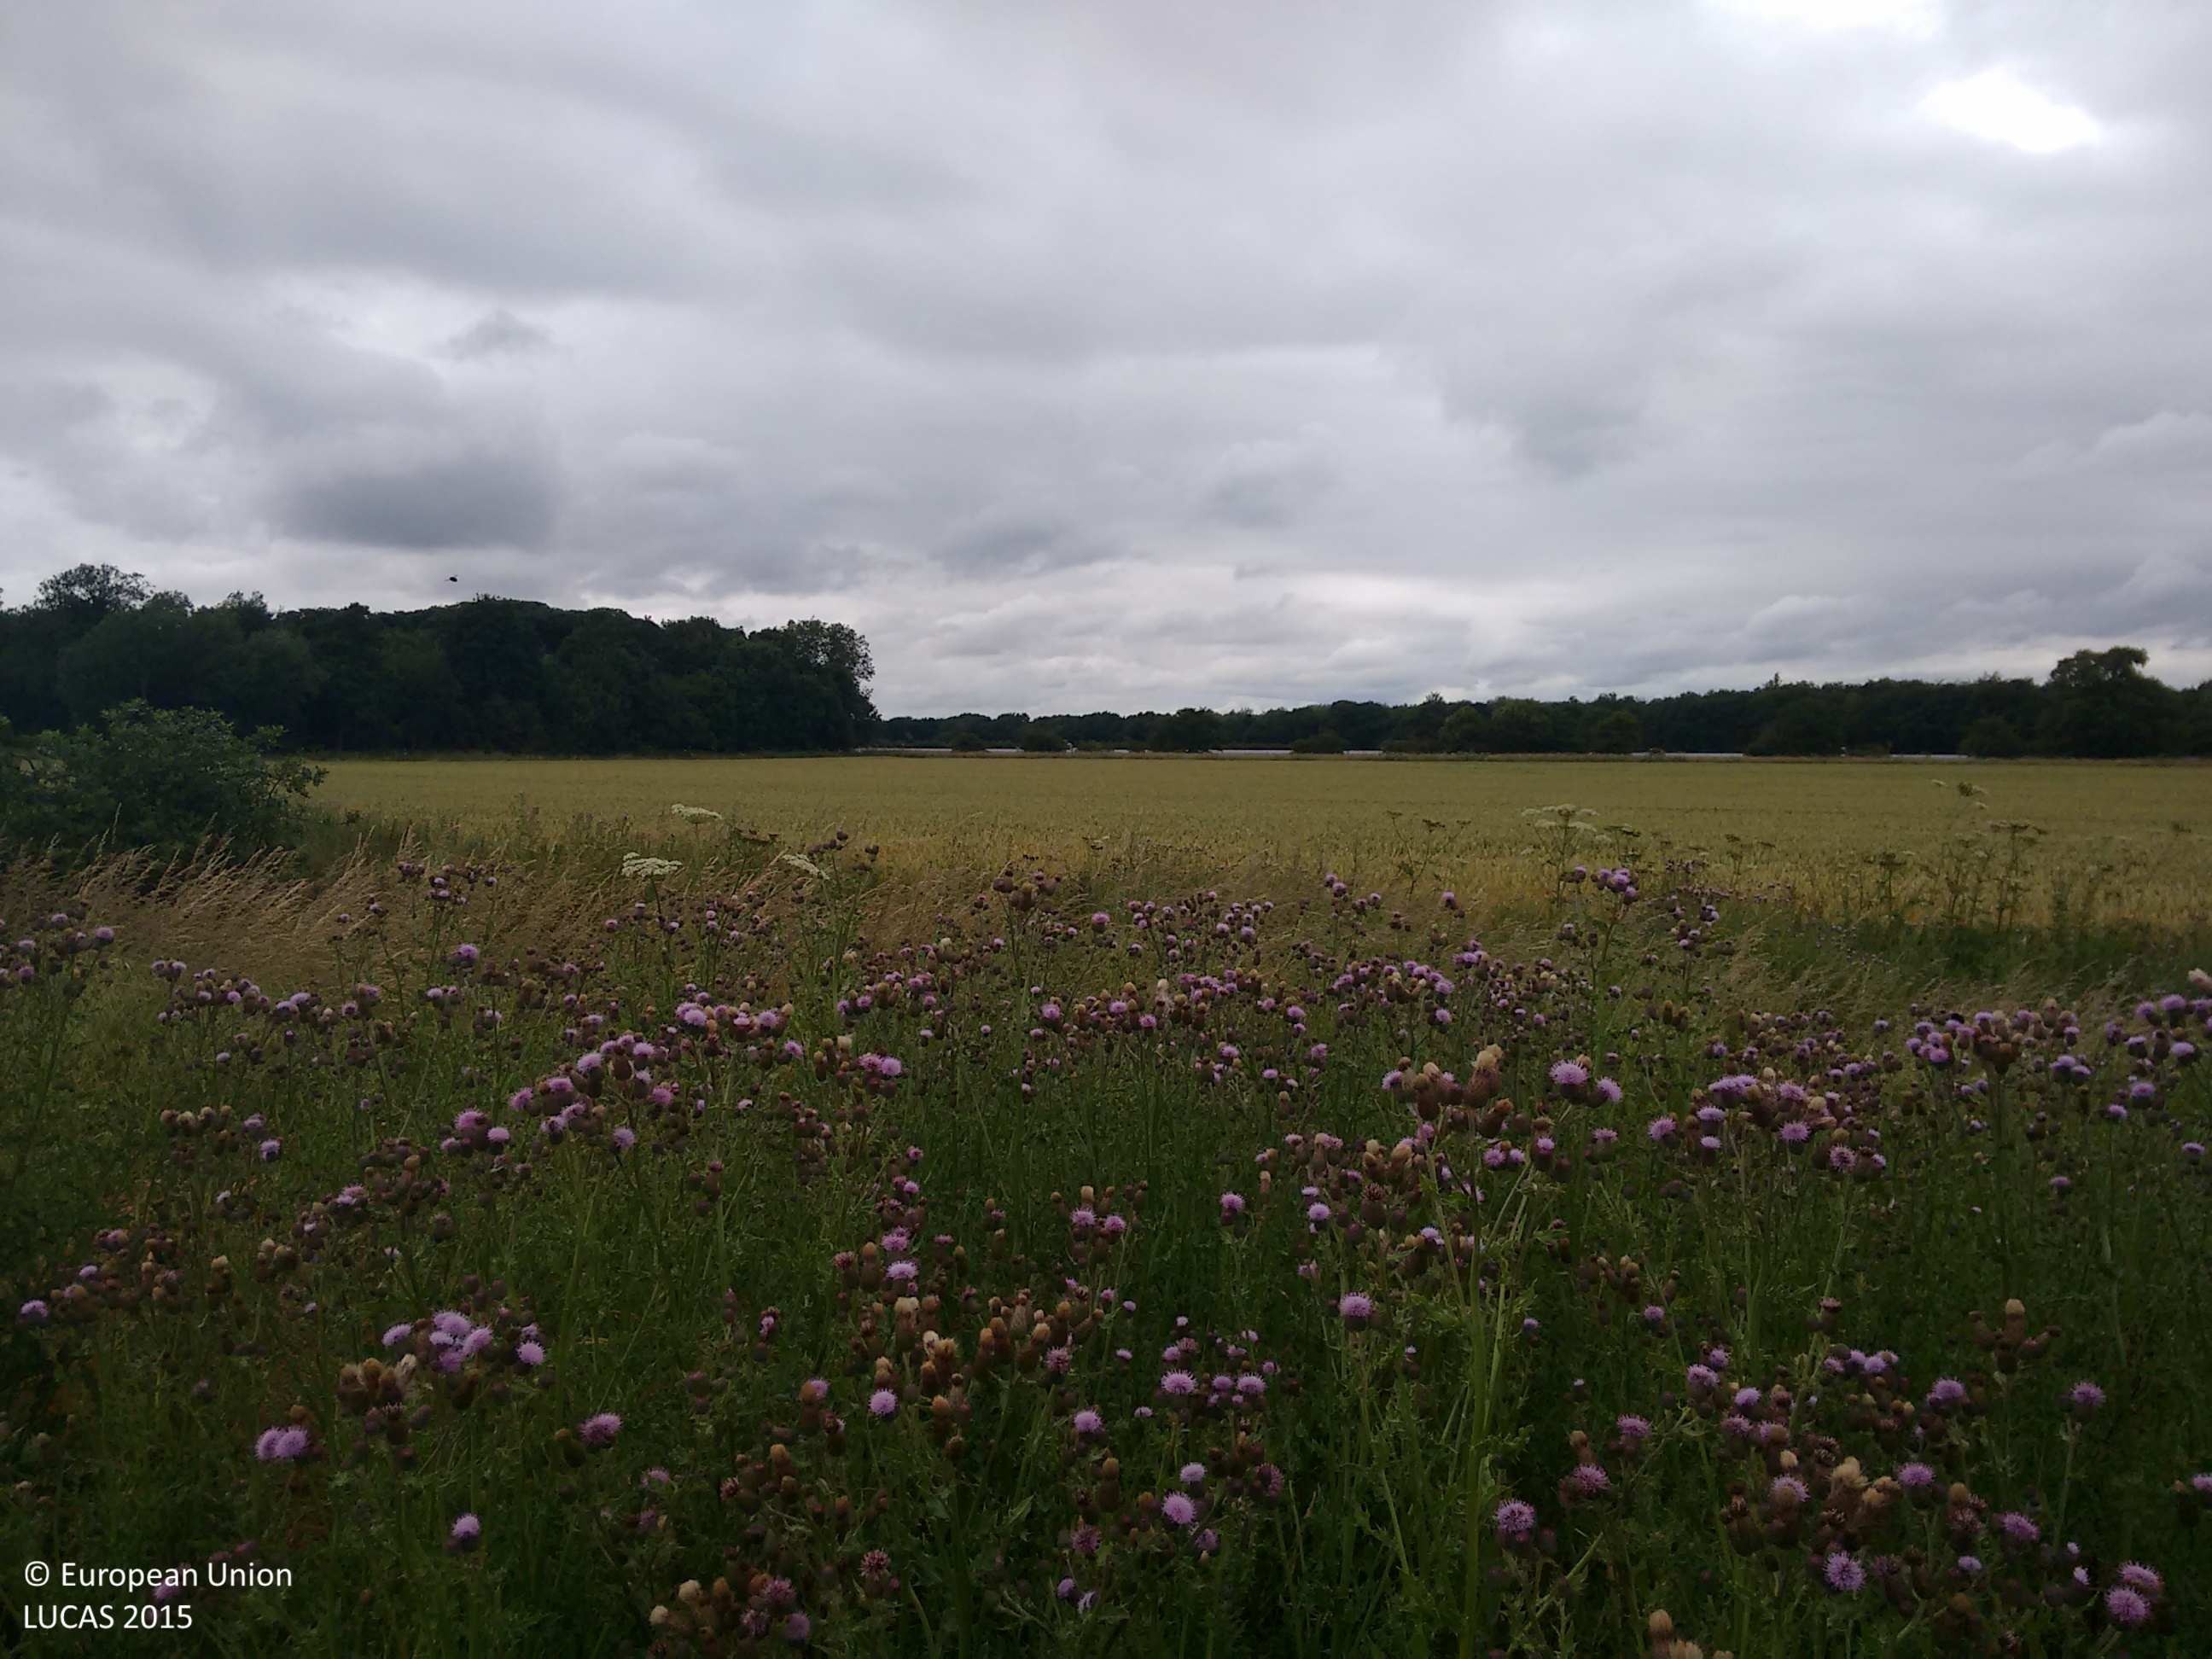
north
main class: Cropland
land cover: Common wheat
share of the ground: > 75 %
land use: Agriculture (excluding fallow land and kitchen gardens)
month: July
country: GB
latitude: 53.3533
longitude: -0.9957
